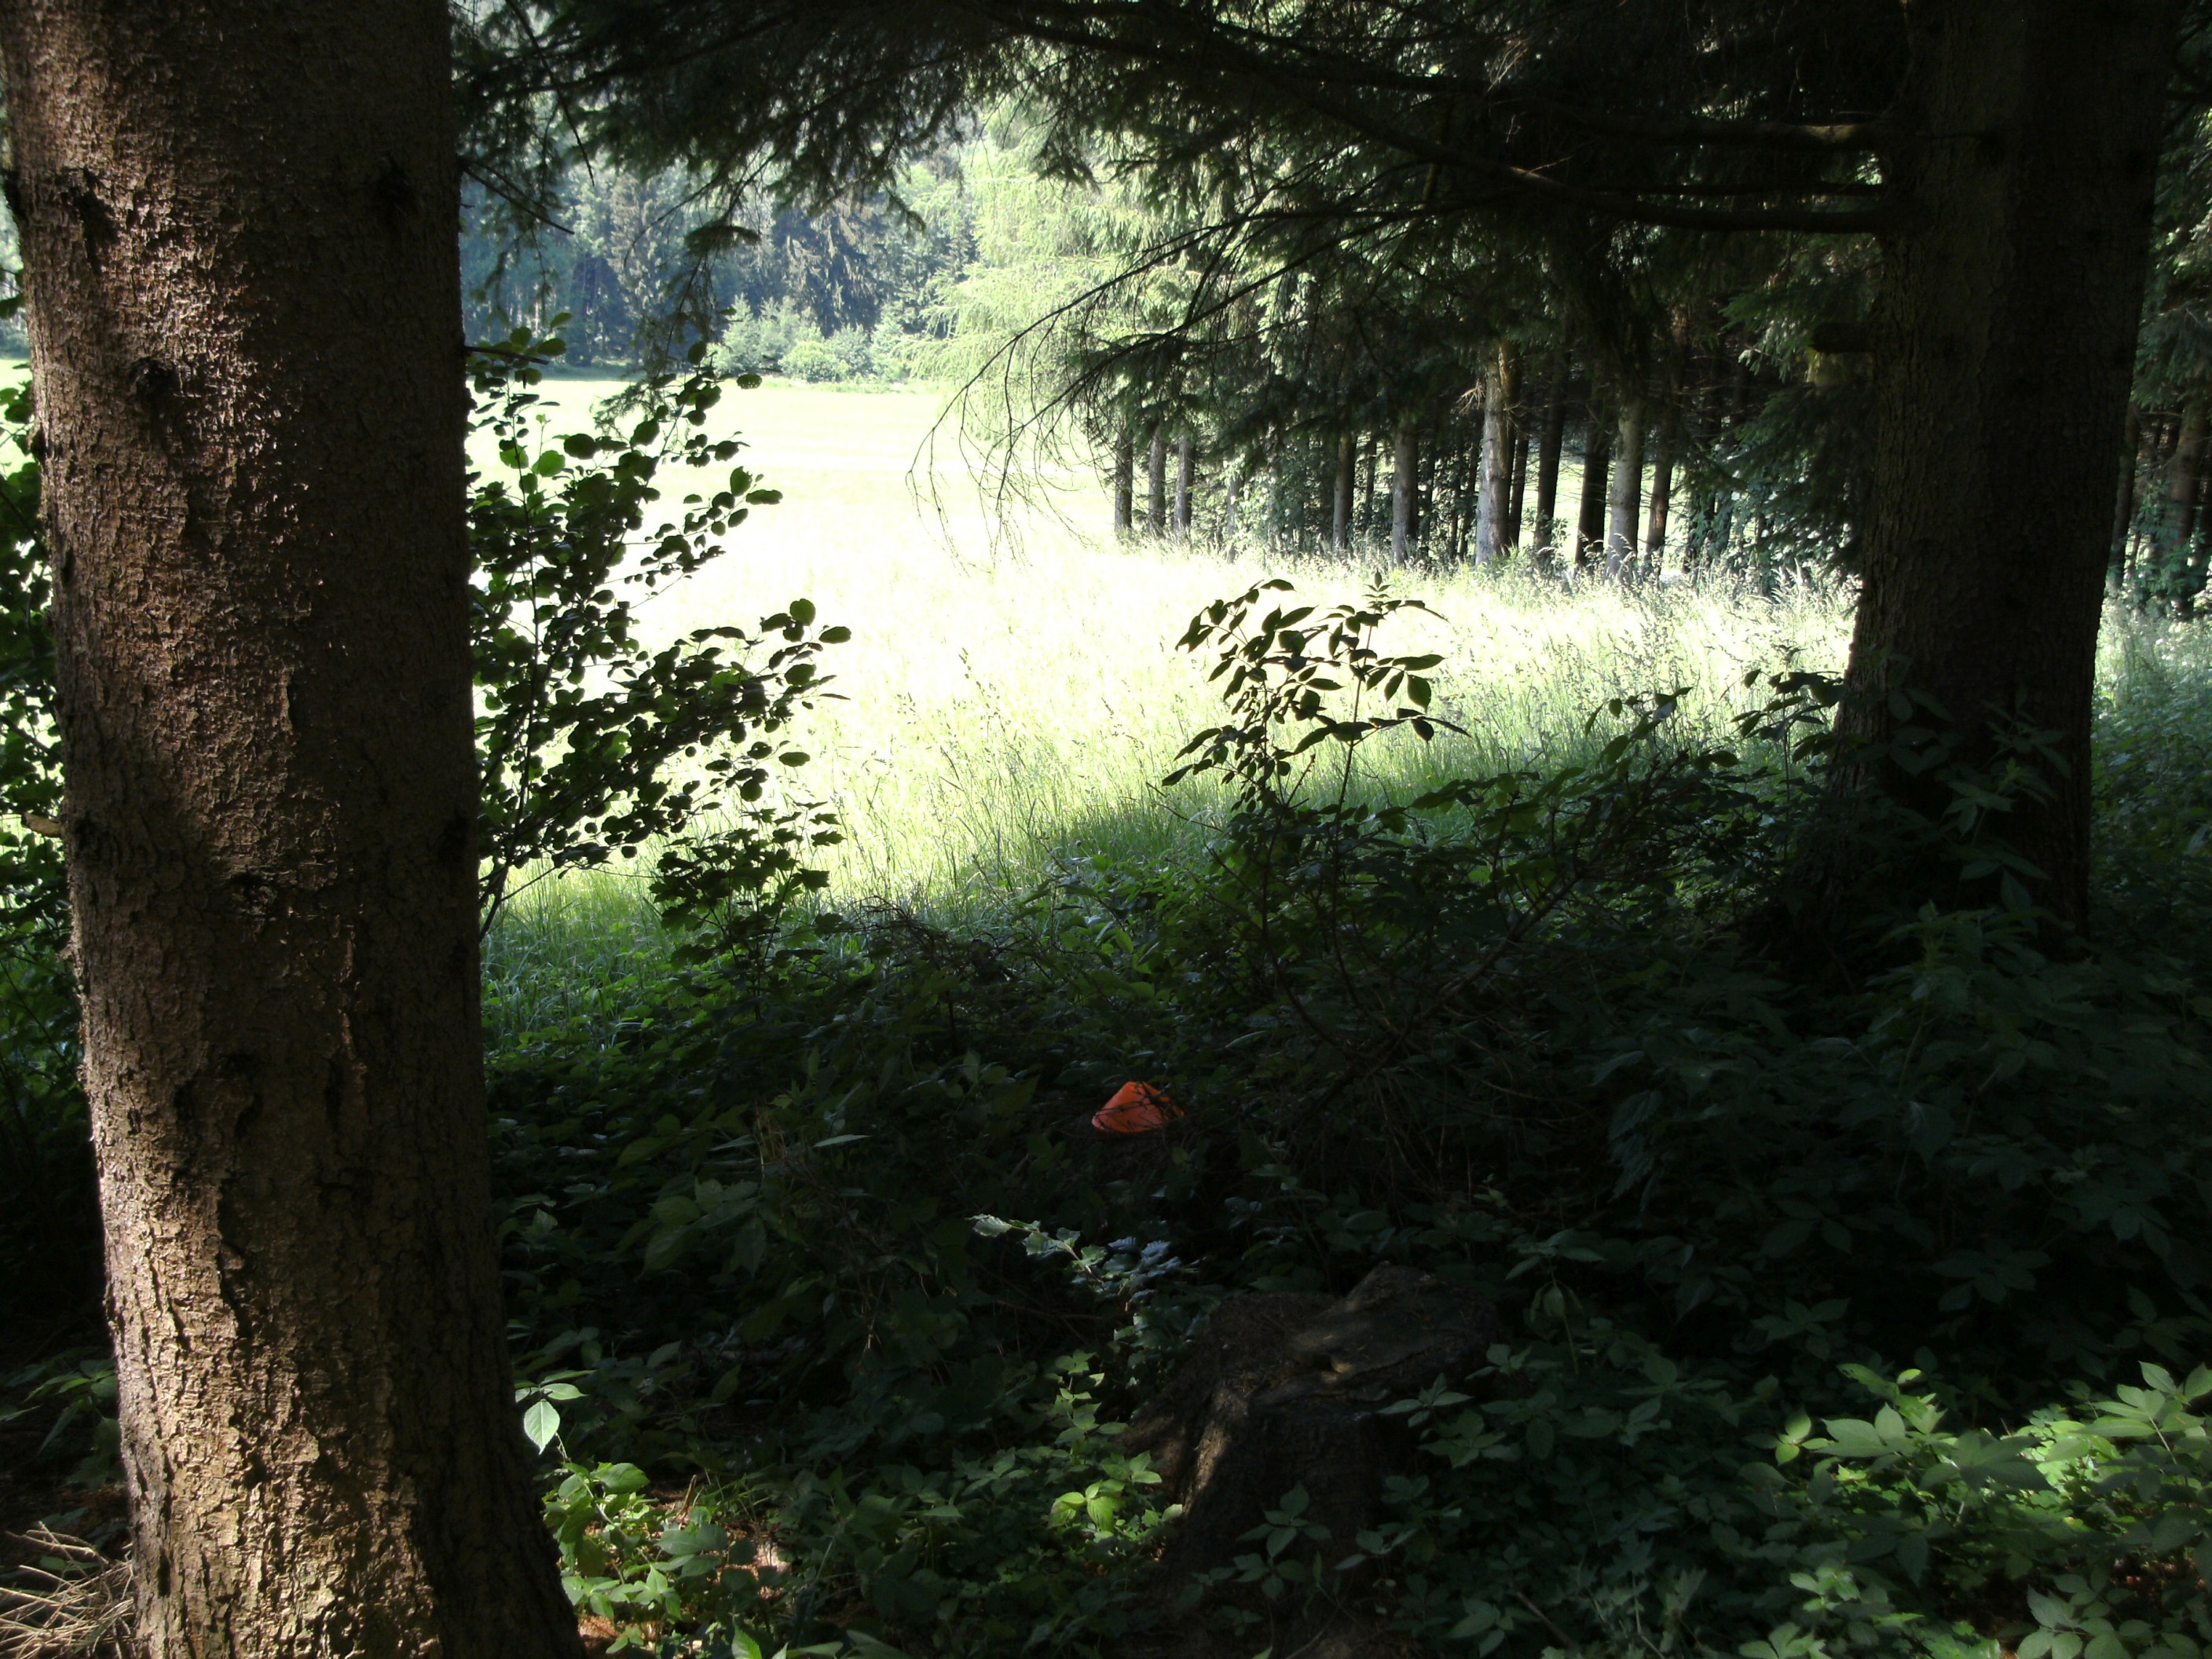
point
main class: Woodland
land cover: Spruce dominated coniferous woodland
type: hemiboreal forest and nemoral coniferous forest and mixed broadleaved-coniferous forest
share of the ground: 50 - 75 %
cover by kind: coniferous forest trees 80 %, herbaceous plants 15 %, shrubs 5 %
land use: Forestry
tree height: > 5 m
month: June
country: AT
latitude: 48.4497
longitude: 14.2050
